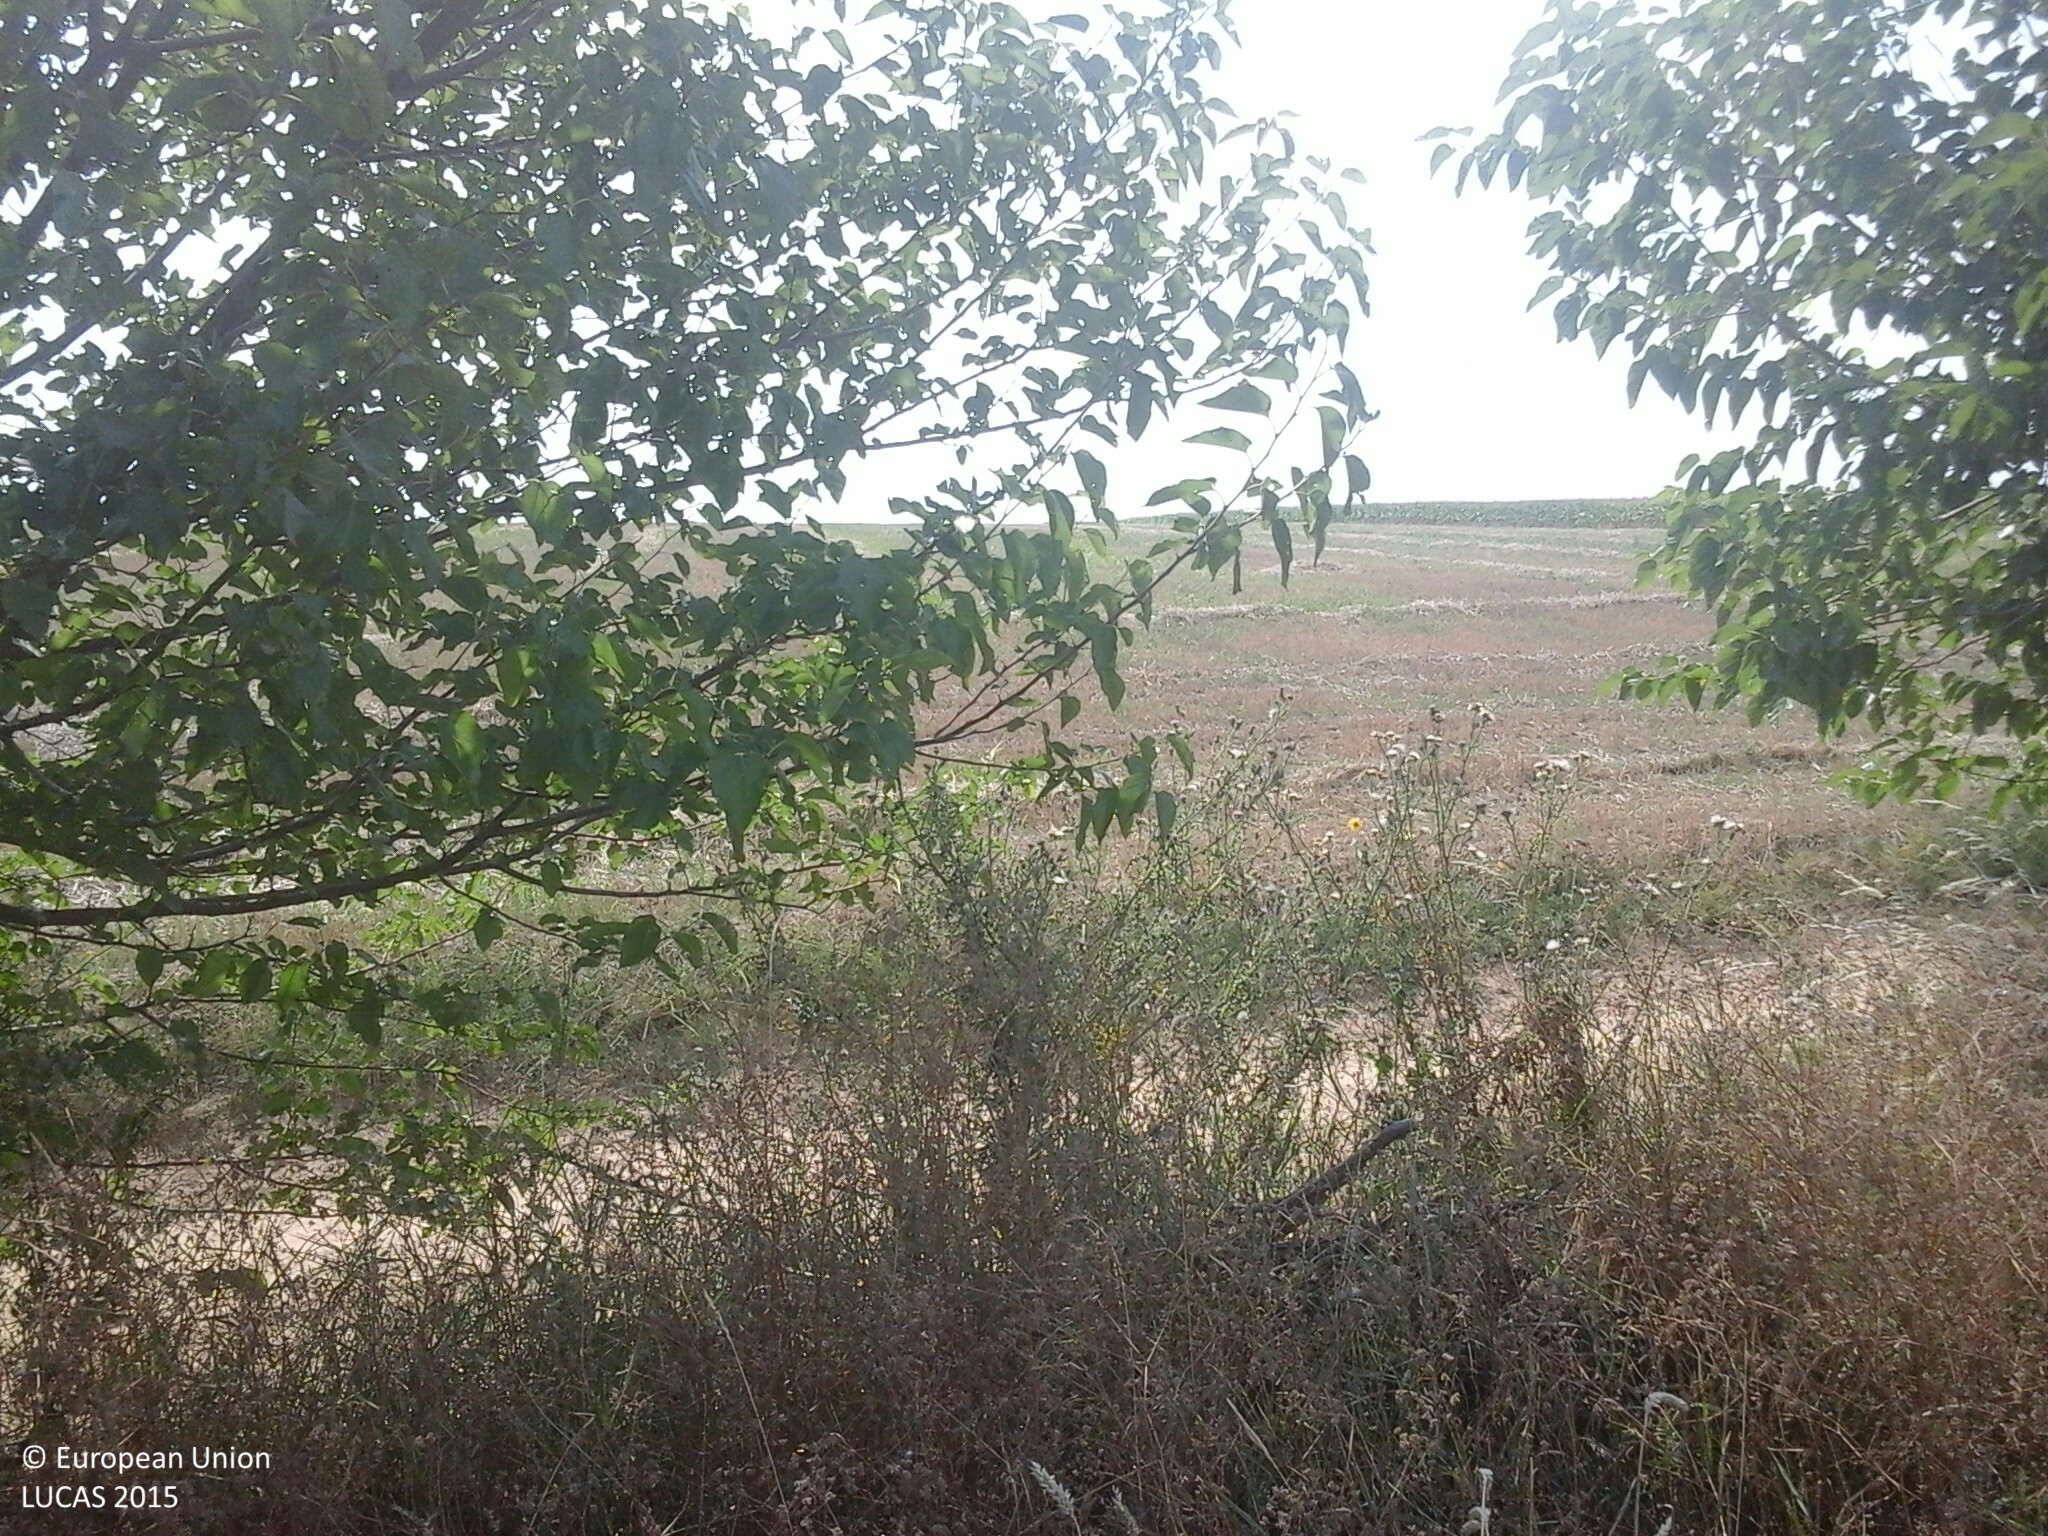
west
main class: Cropland
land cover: Common wheat
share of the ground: 10 - 25 %
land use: Agriculture (excluding fallow land and kitchen gardens)
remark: Harvested field
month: August
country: HU
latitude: 45.9774
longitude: 18.2546
